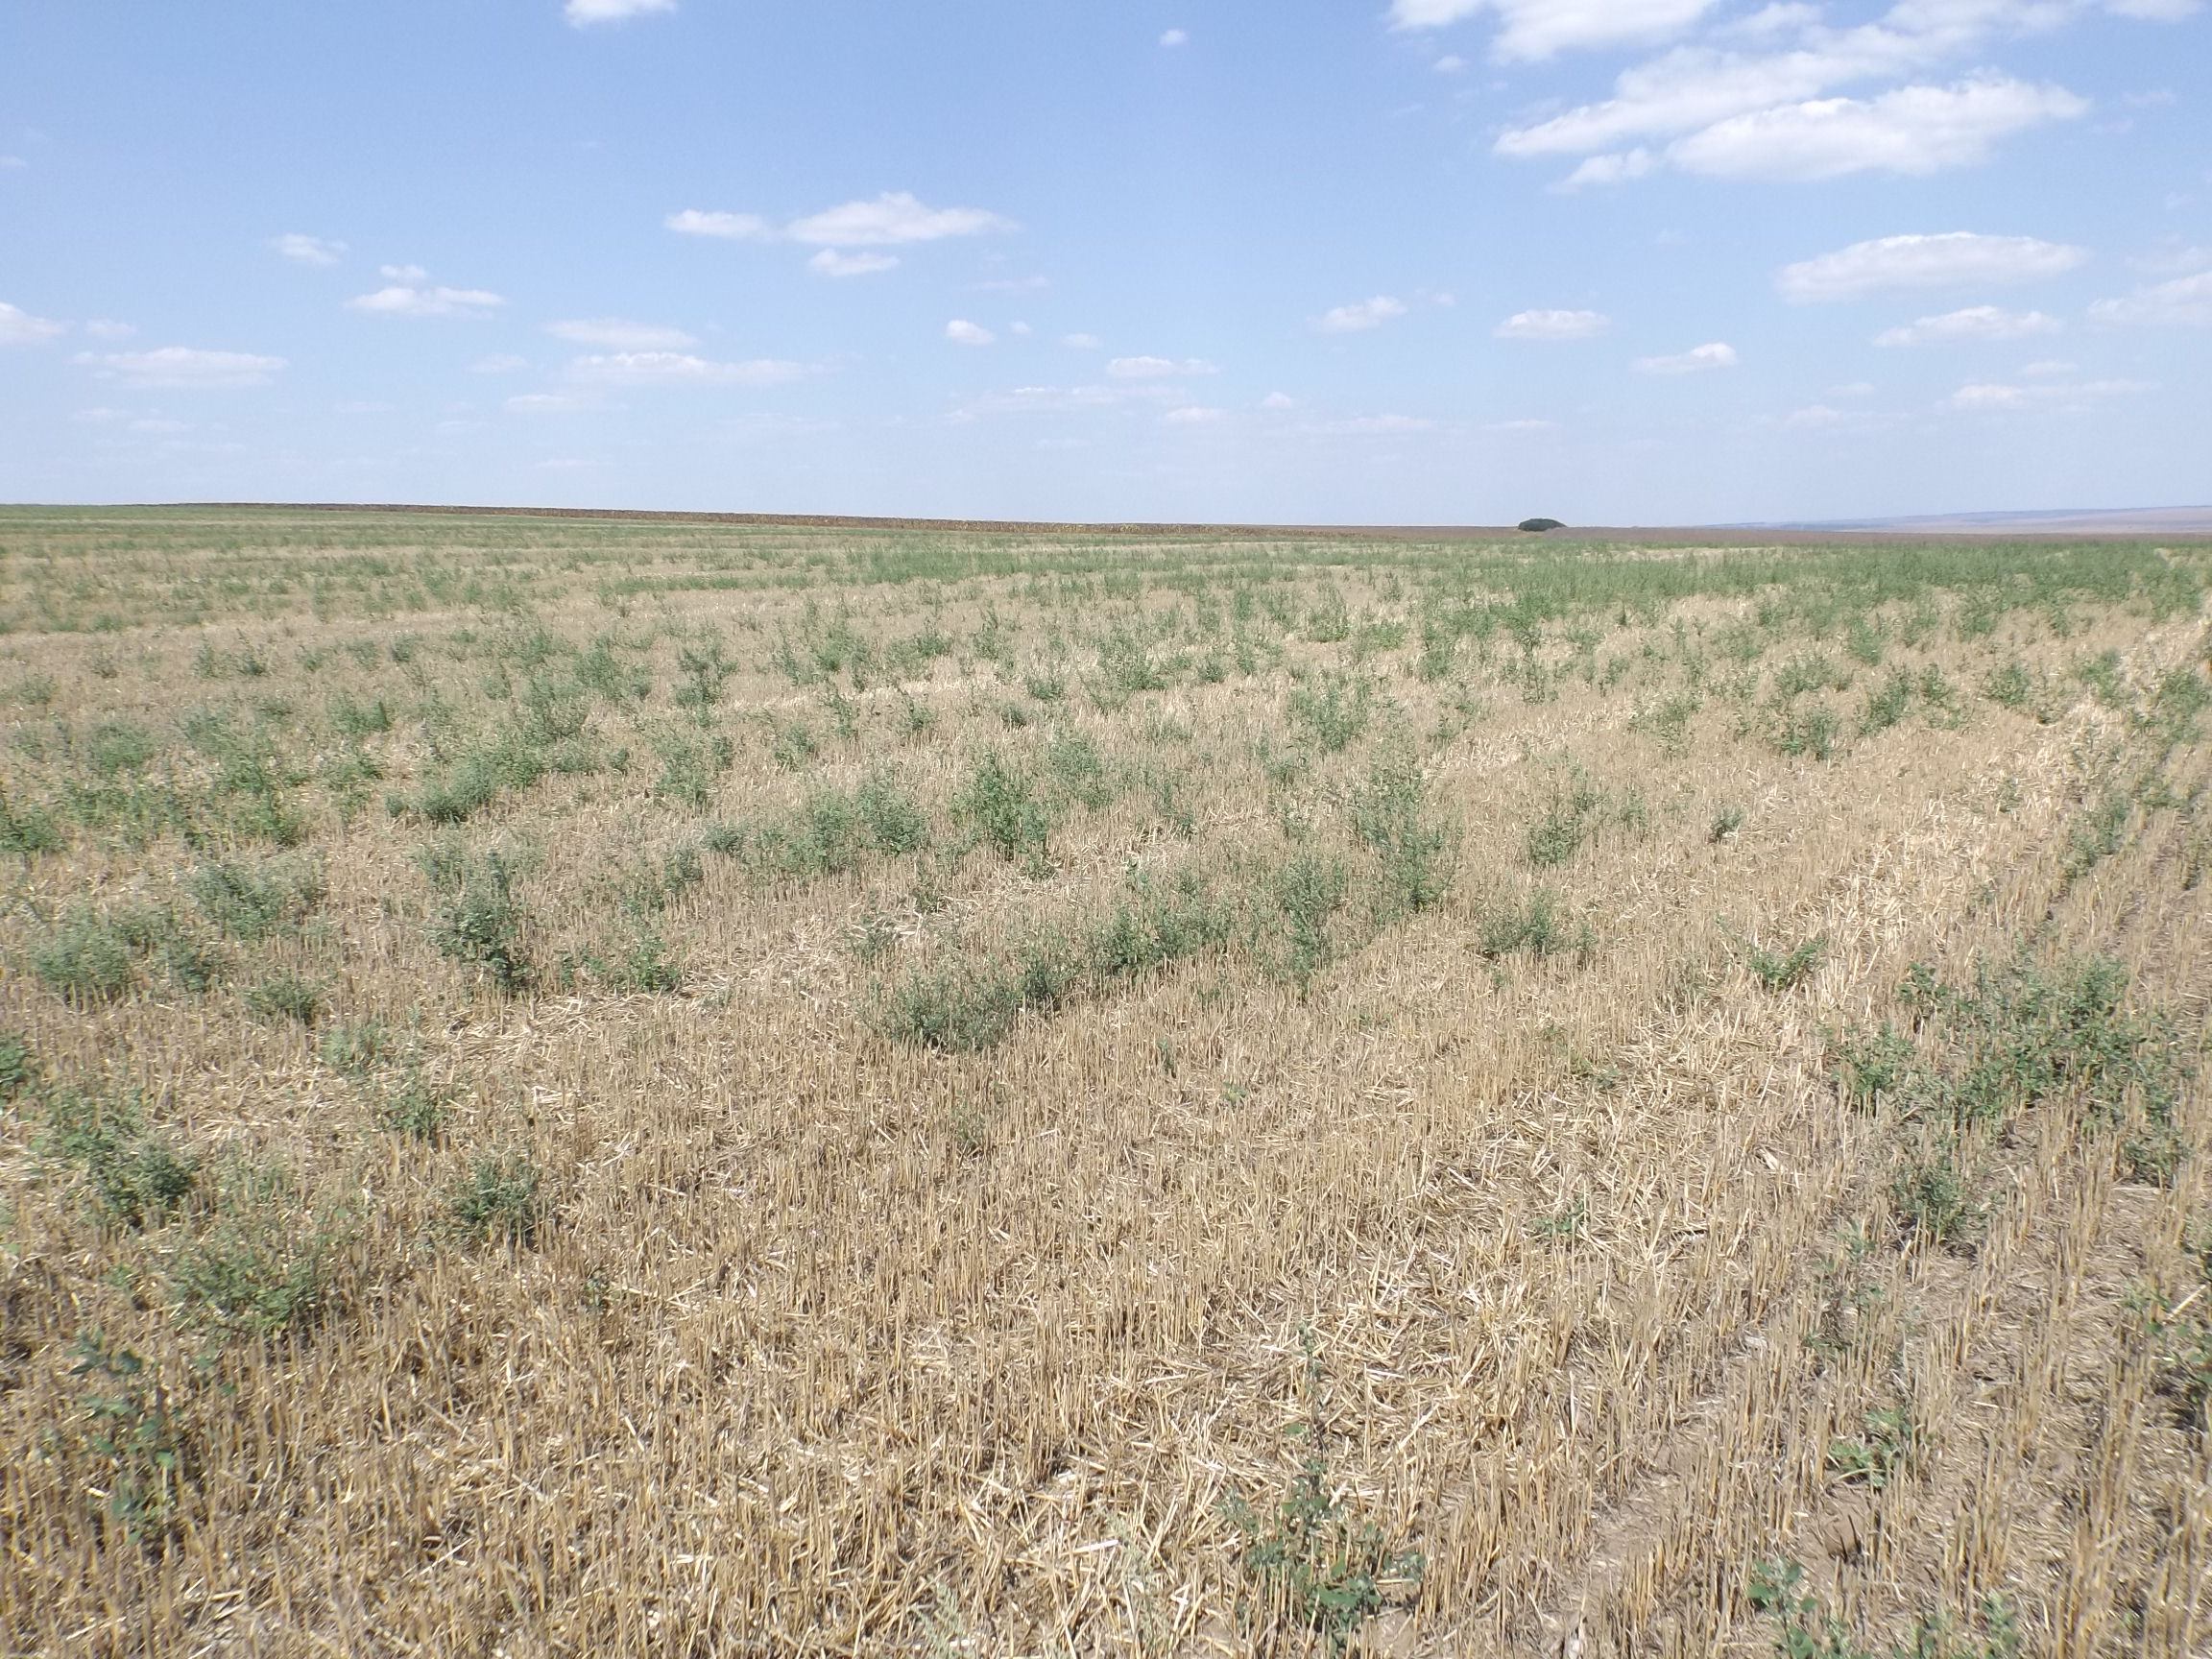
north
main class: Cropland
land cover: Common wheat
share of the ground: 50 - 75 %
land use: Agriculture (excluding fallow land and kitchen gardens)
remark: Harvested field
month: August
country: BG
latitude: 43.4406
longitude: 27.4893
